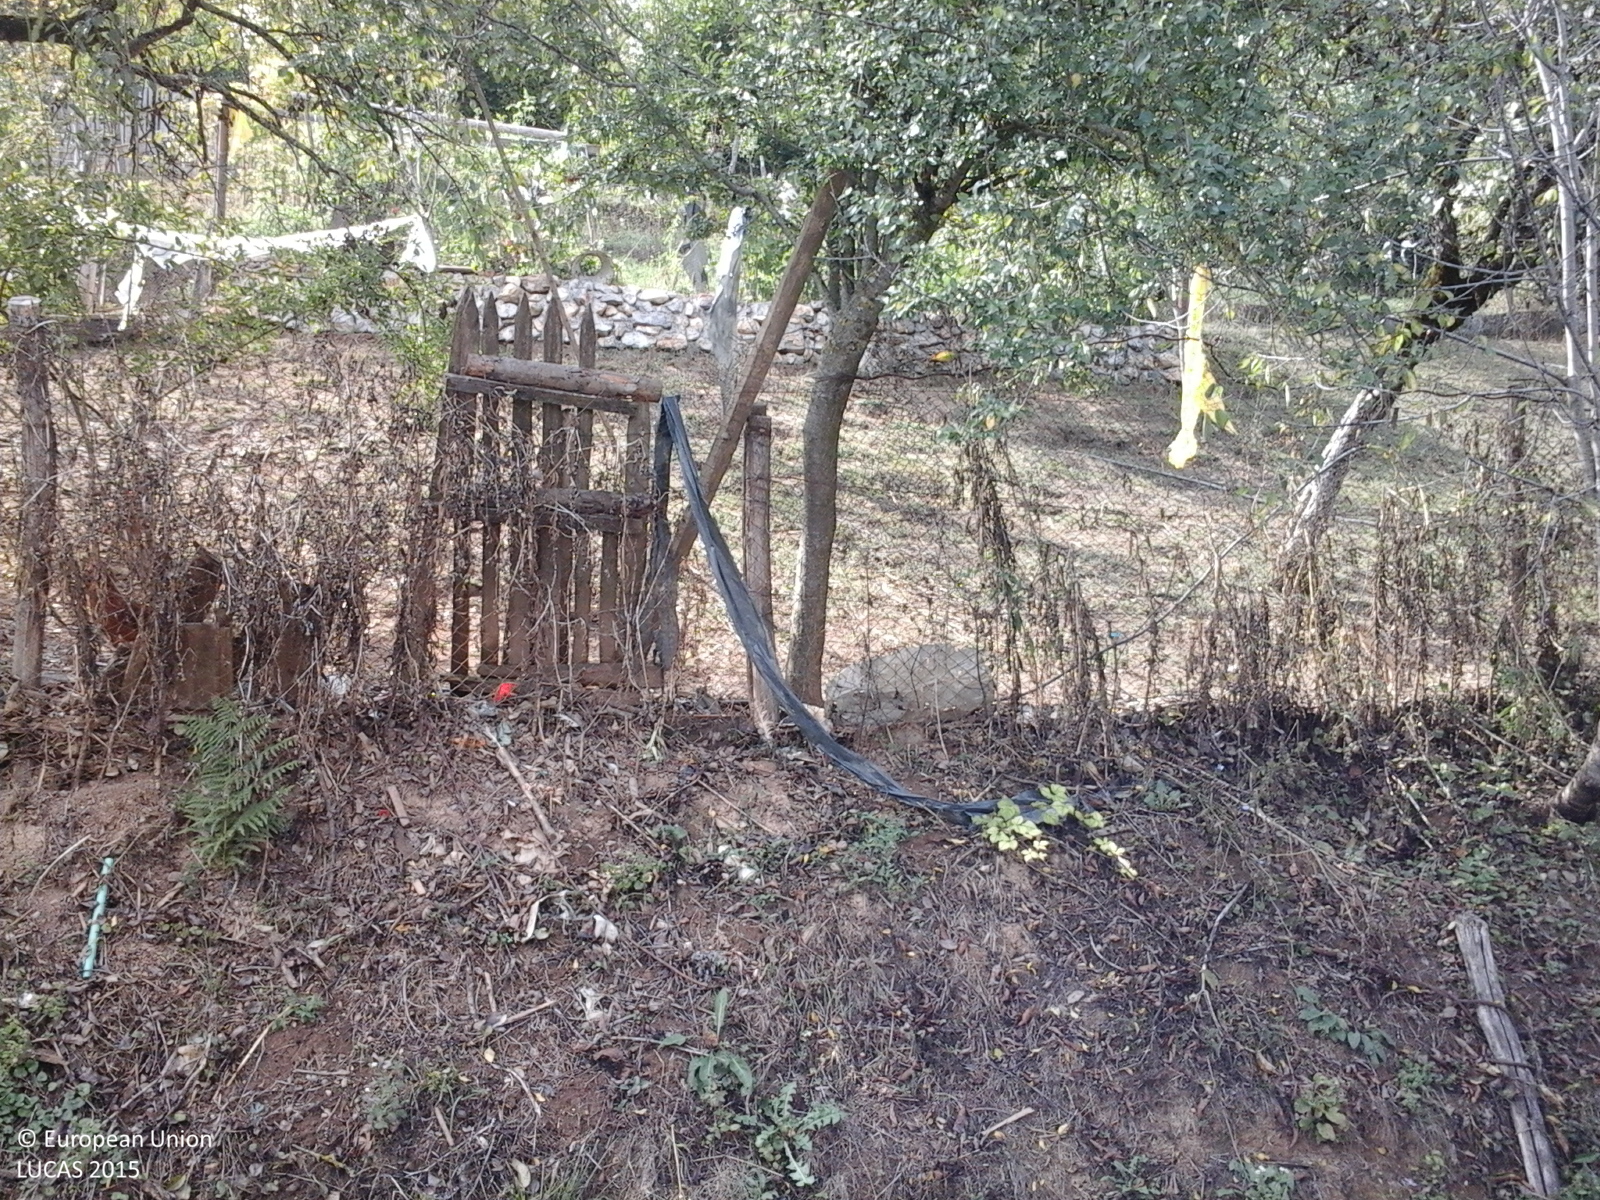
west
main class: Cropland
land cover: Maize
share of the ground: > 75 %
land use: Agriculture (excluding fallow land and kitchen gardens)
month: September
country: RO
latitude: 46.7767
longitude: 22.3752
